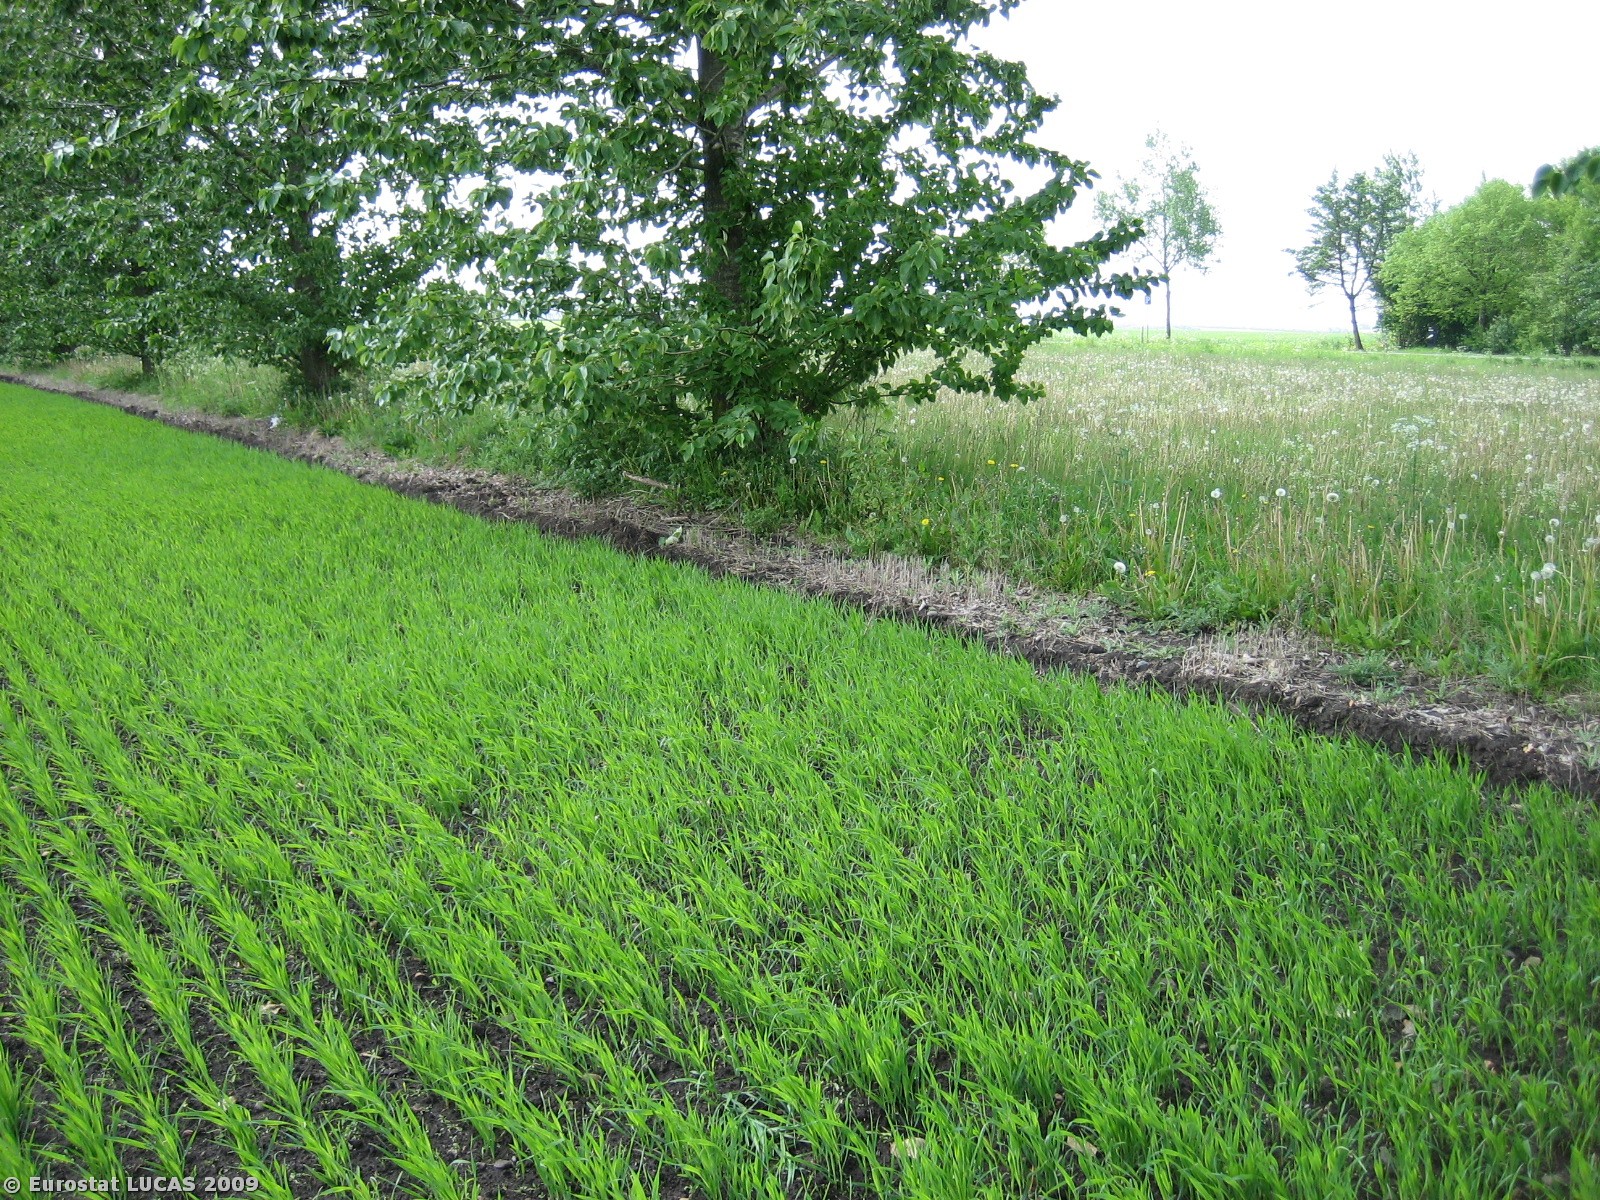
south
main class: Cropland
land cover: Oats
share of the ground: > 75 %
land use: Agriculture (excluding fallow land and kitchen gardens)
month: May
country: DK
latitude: 56.2540
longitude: 8.7909
